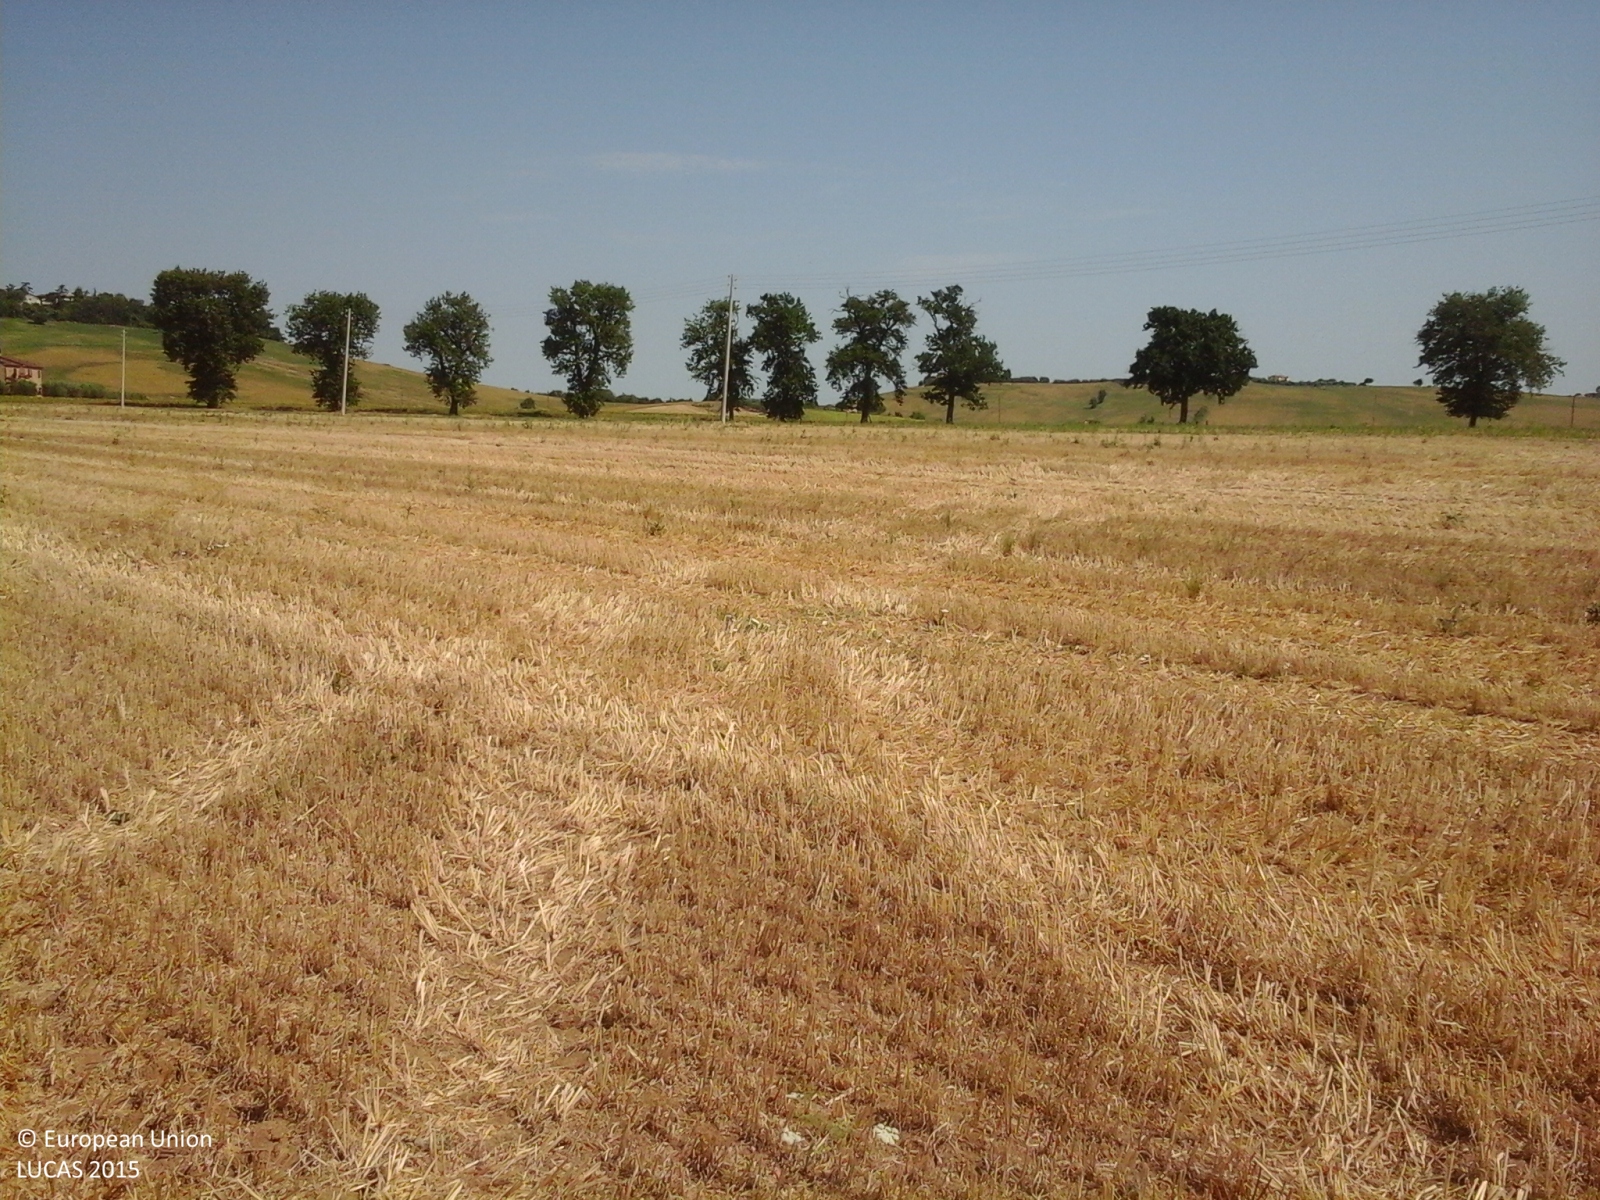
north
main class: Cropland
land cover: Durum wheat
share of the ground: > 75 %
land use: Agriculture (excluding fallow land and kitchen gardens)
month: July
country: IT
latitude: 43.2482
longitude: 13.3782
